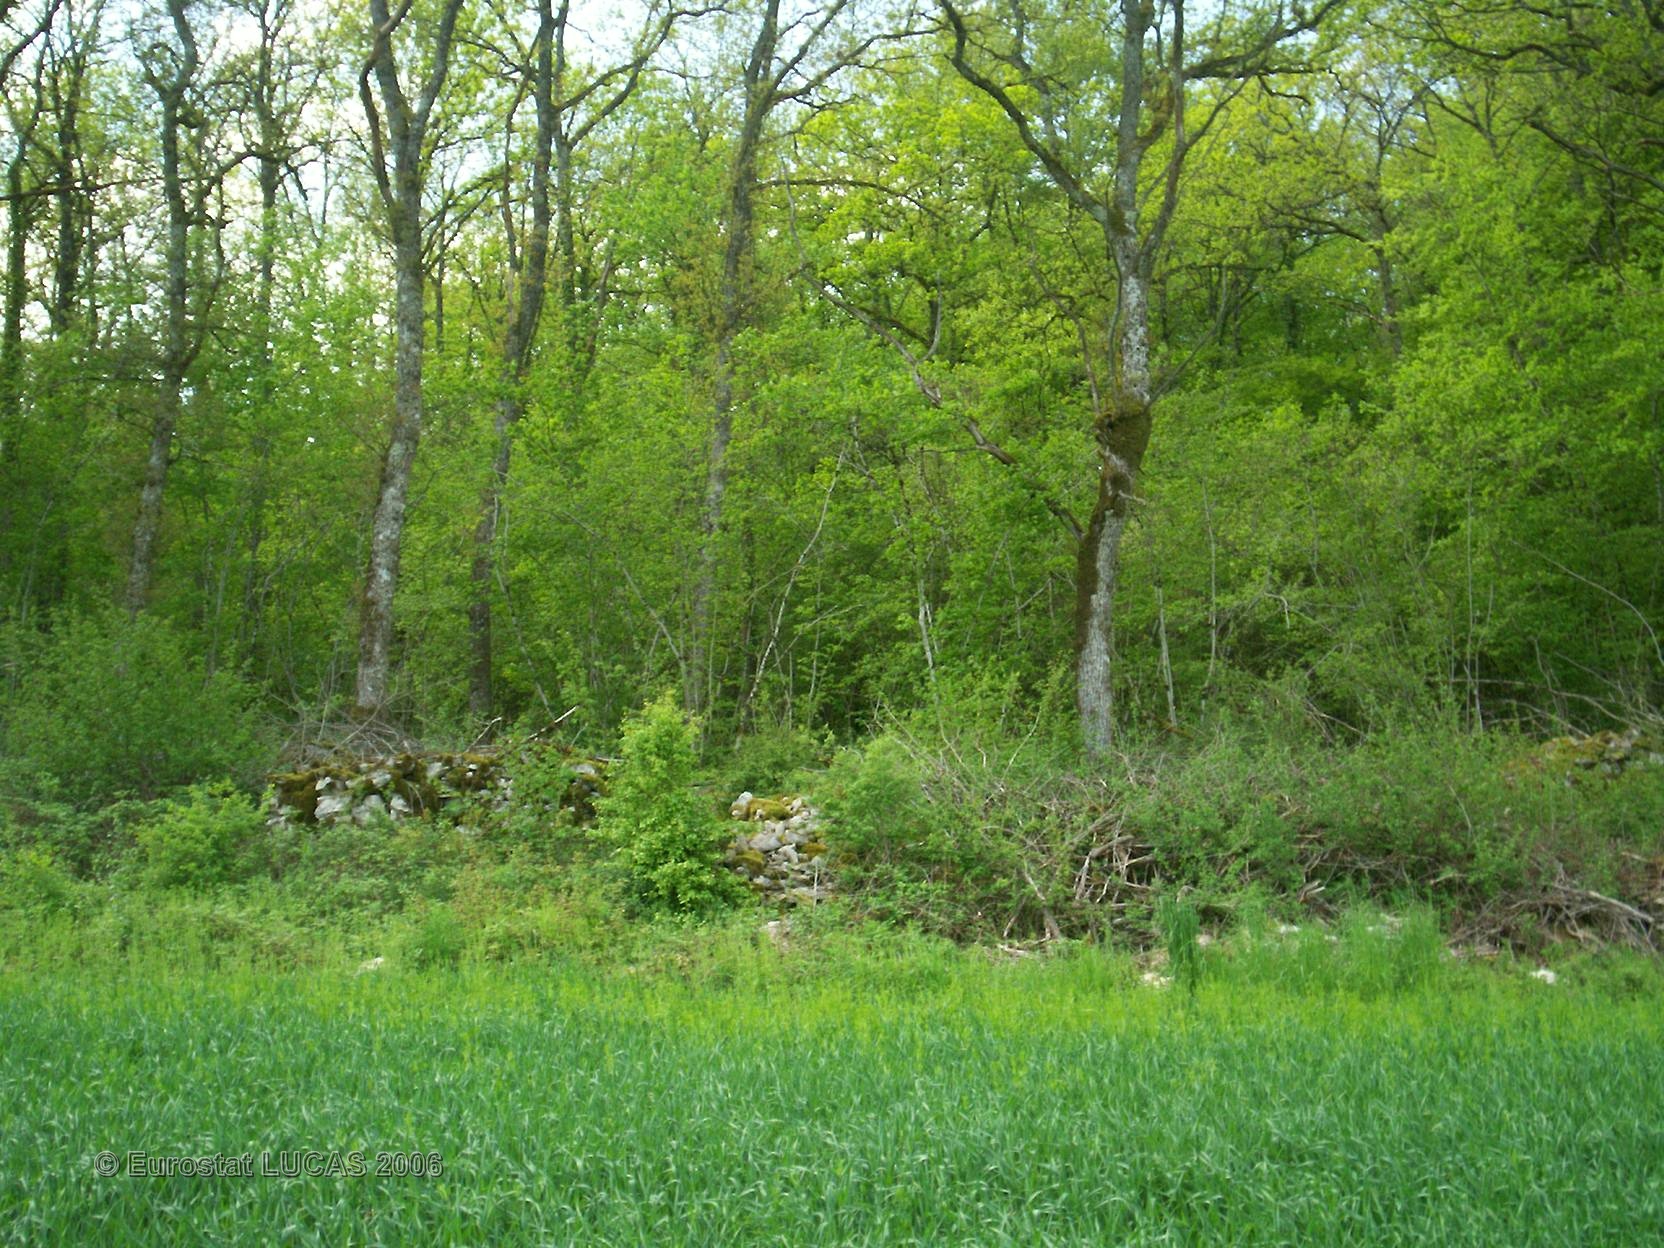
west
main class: Cropland
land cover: Common wheat
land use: Agriculture (excluding fallow land and kitchen gardens)
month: May
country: FR
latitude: 47.7138
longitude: 4.6272
